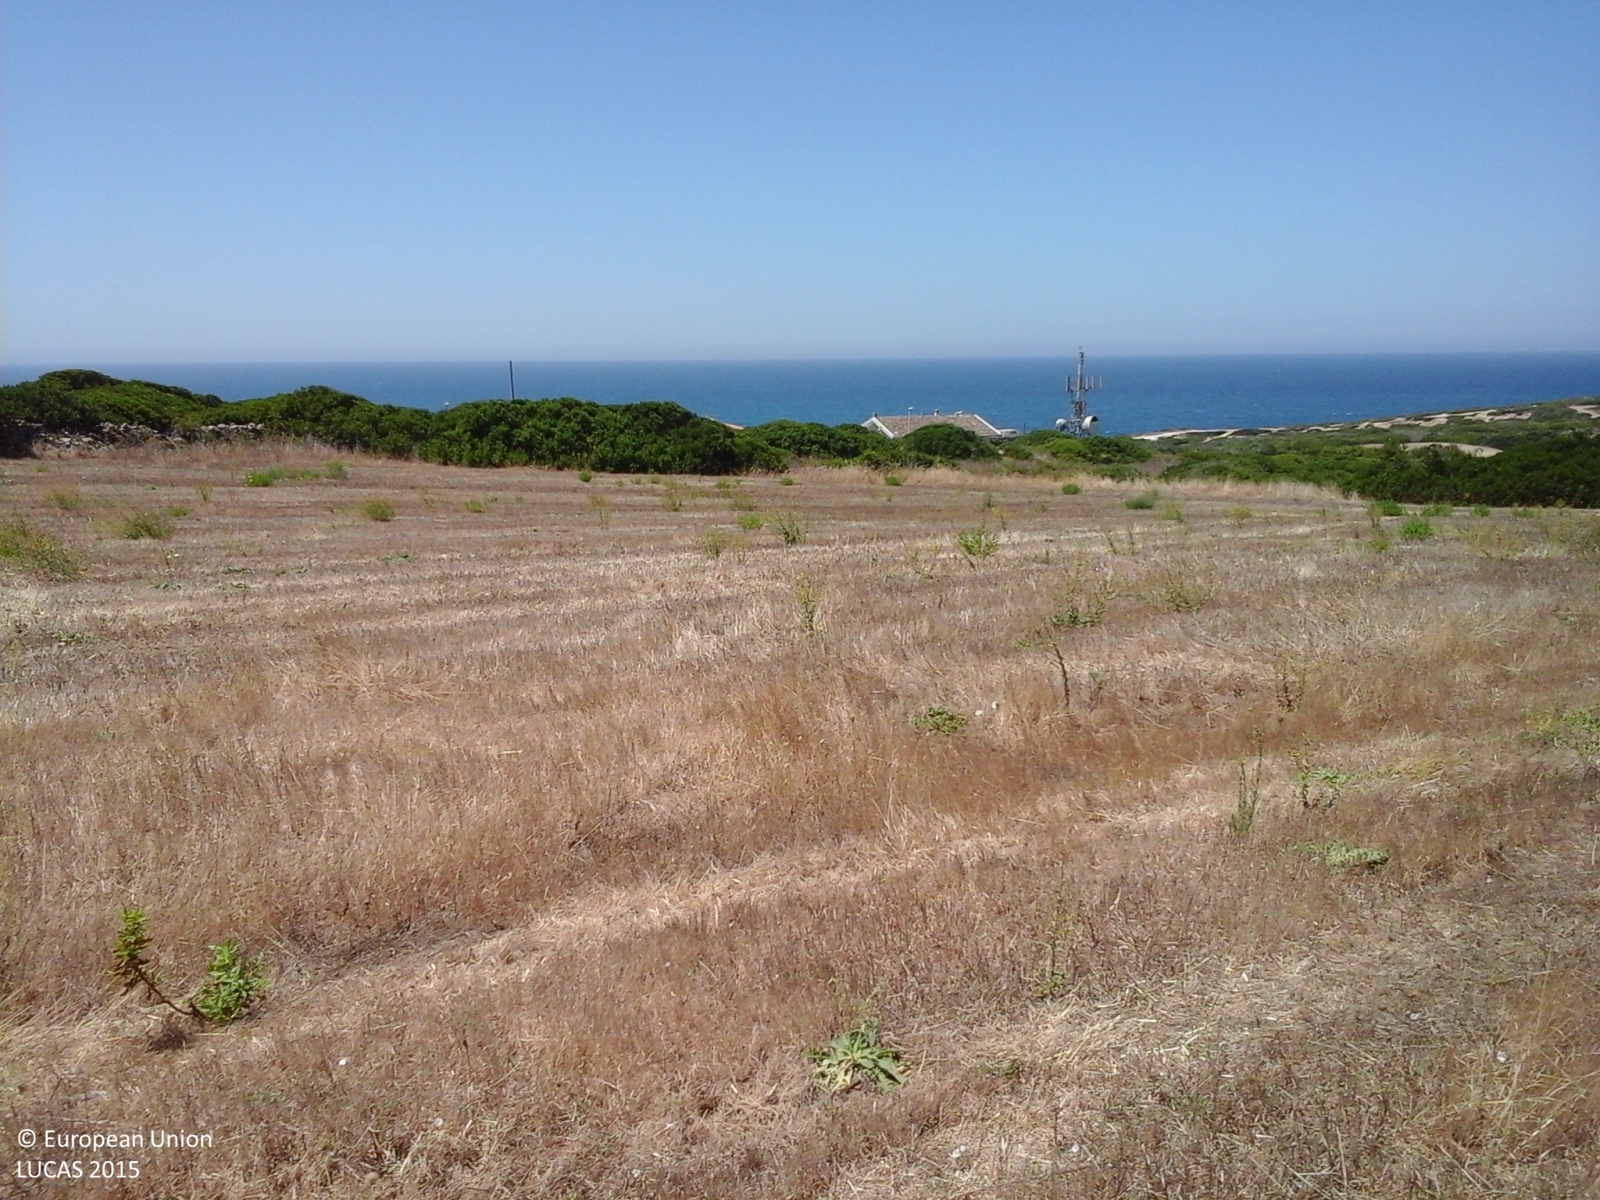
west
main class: Grassland
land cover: Grassland without tree/shrub cover
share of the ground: > 75 %
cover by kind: herbaceous plants 100 %
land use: Agriculture (excluding fallow land and kitchen gardens)
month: August
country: IT
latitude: 40.0928
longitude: 8.4950
